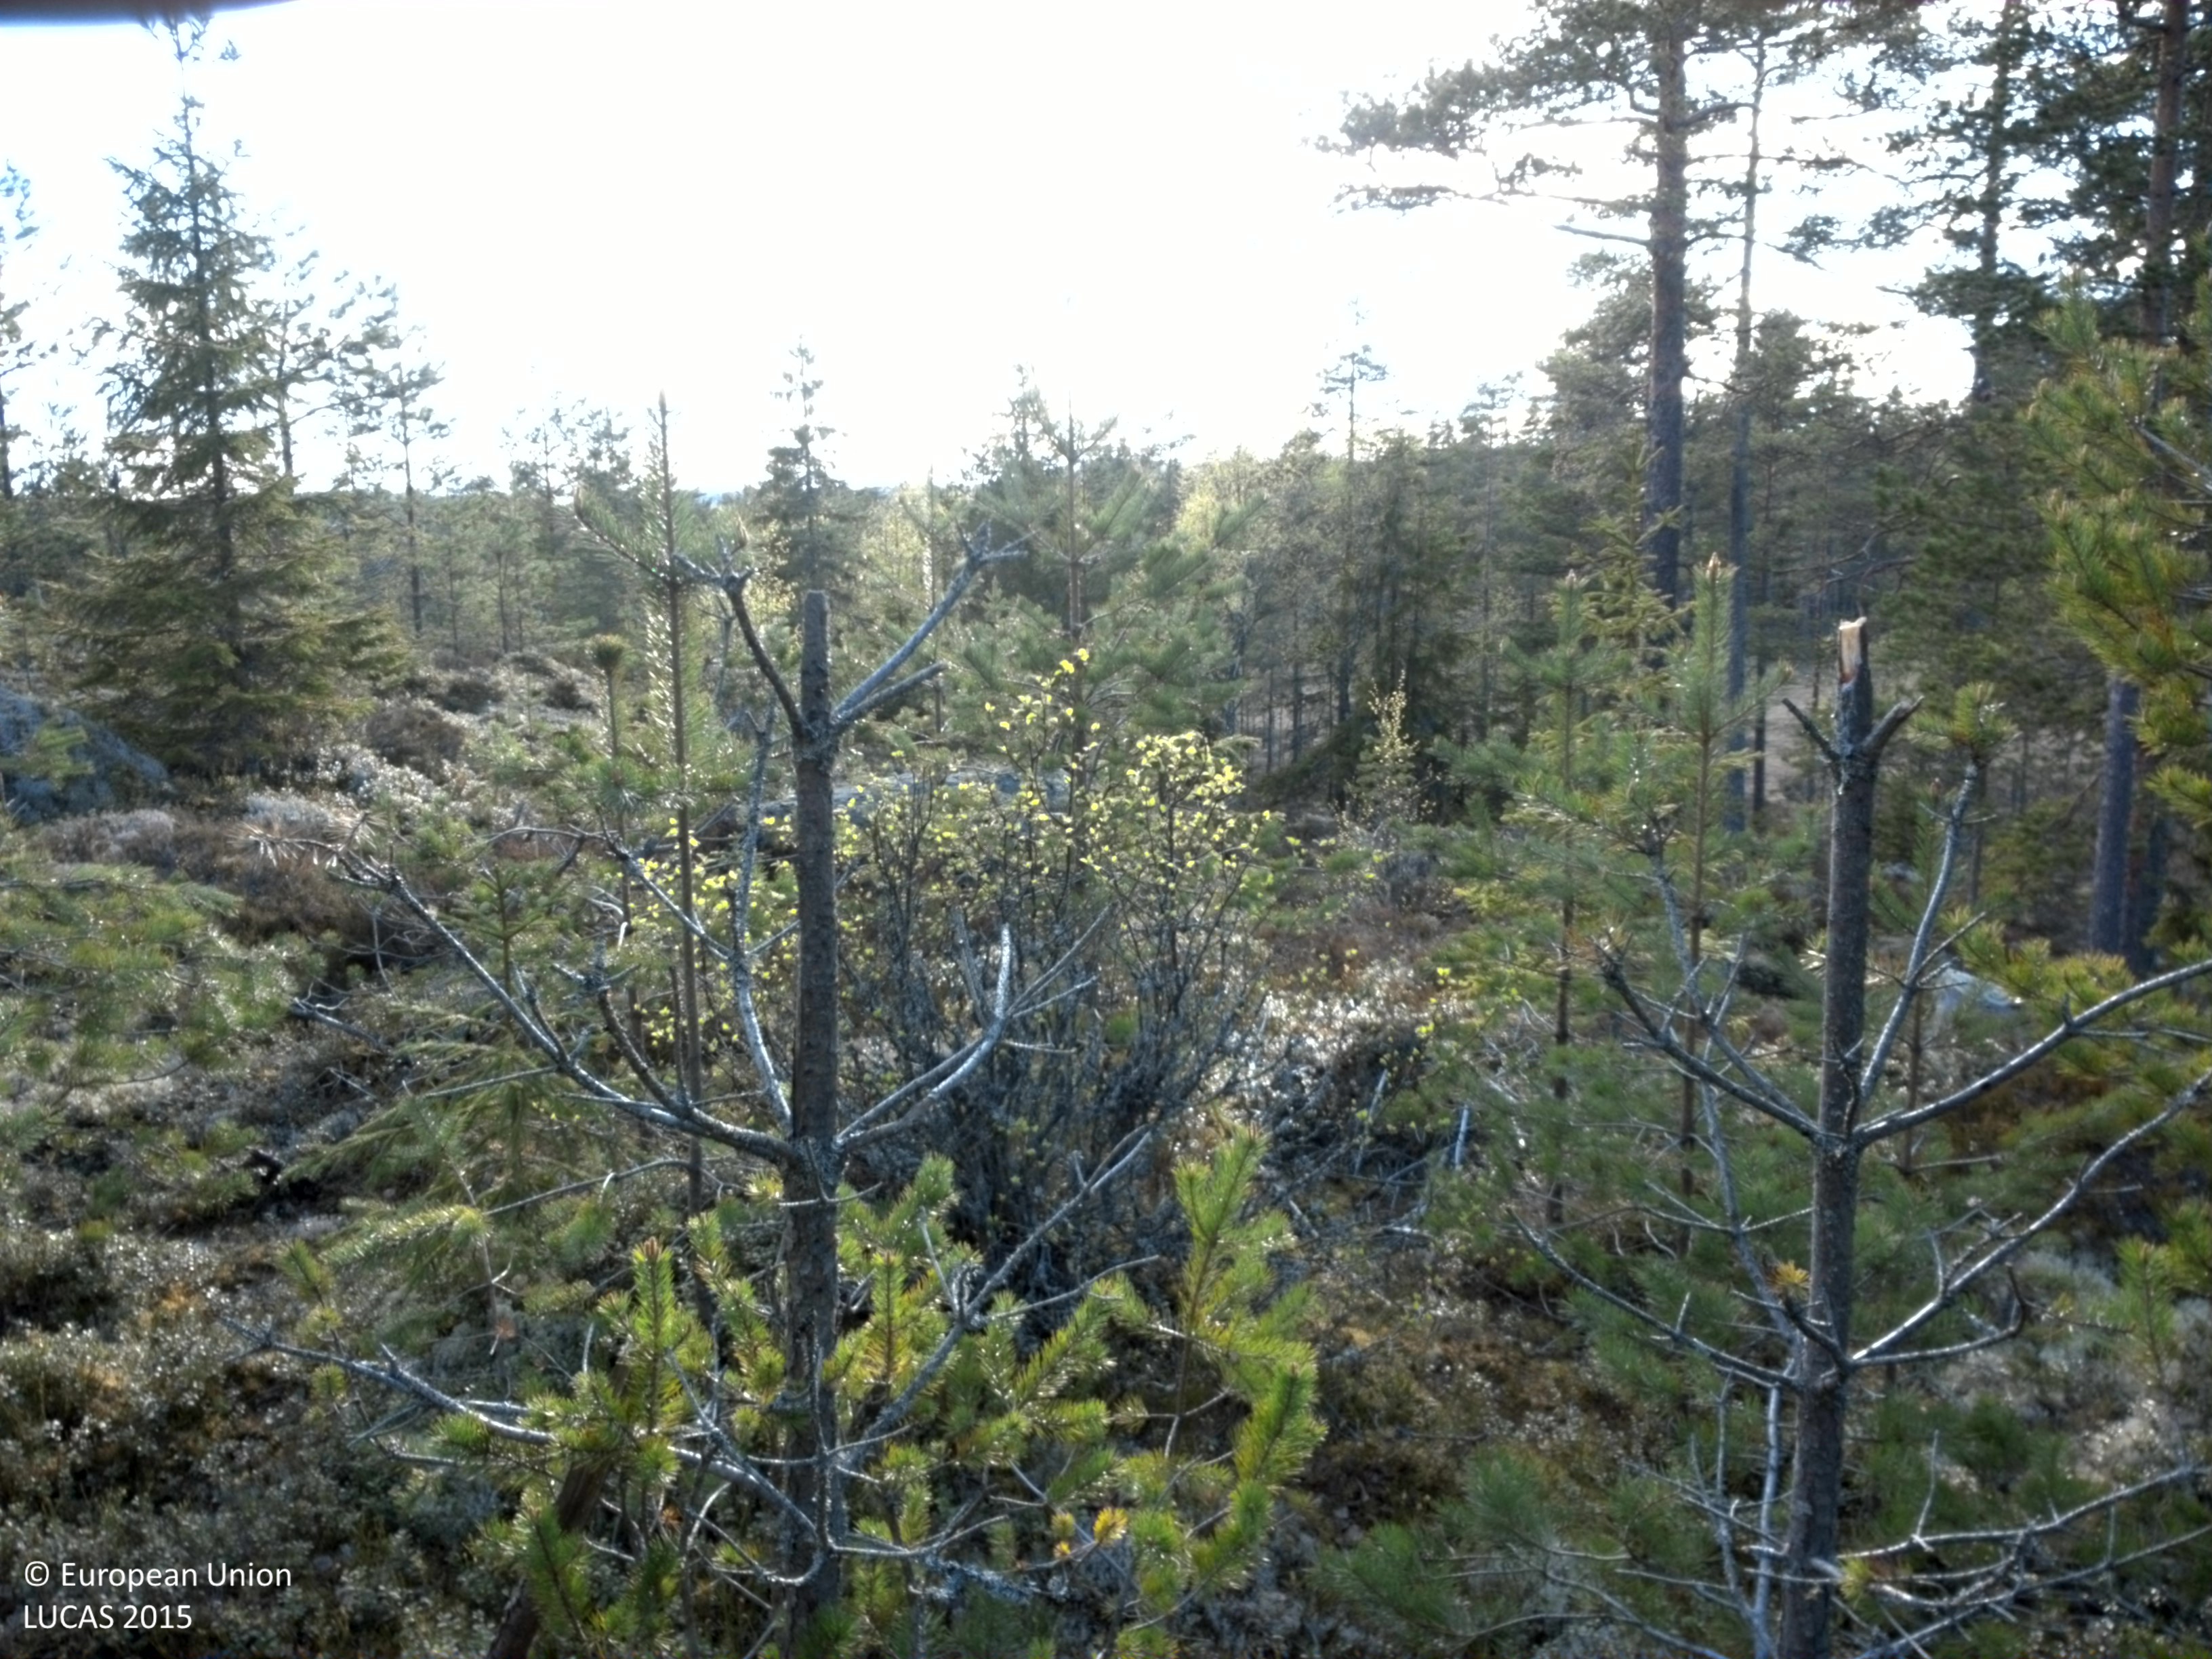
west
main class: Woodland
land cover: Pine dominated coniferous woodland
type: boreal forest
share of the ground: > 75 %
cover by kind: coniferous forest trees 80 %, shrubs 10 %, lichens and mosses 10 %
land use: Forestry
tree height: > 5 m
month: May
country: SE
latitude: 60.2878
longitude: 13.2284
